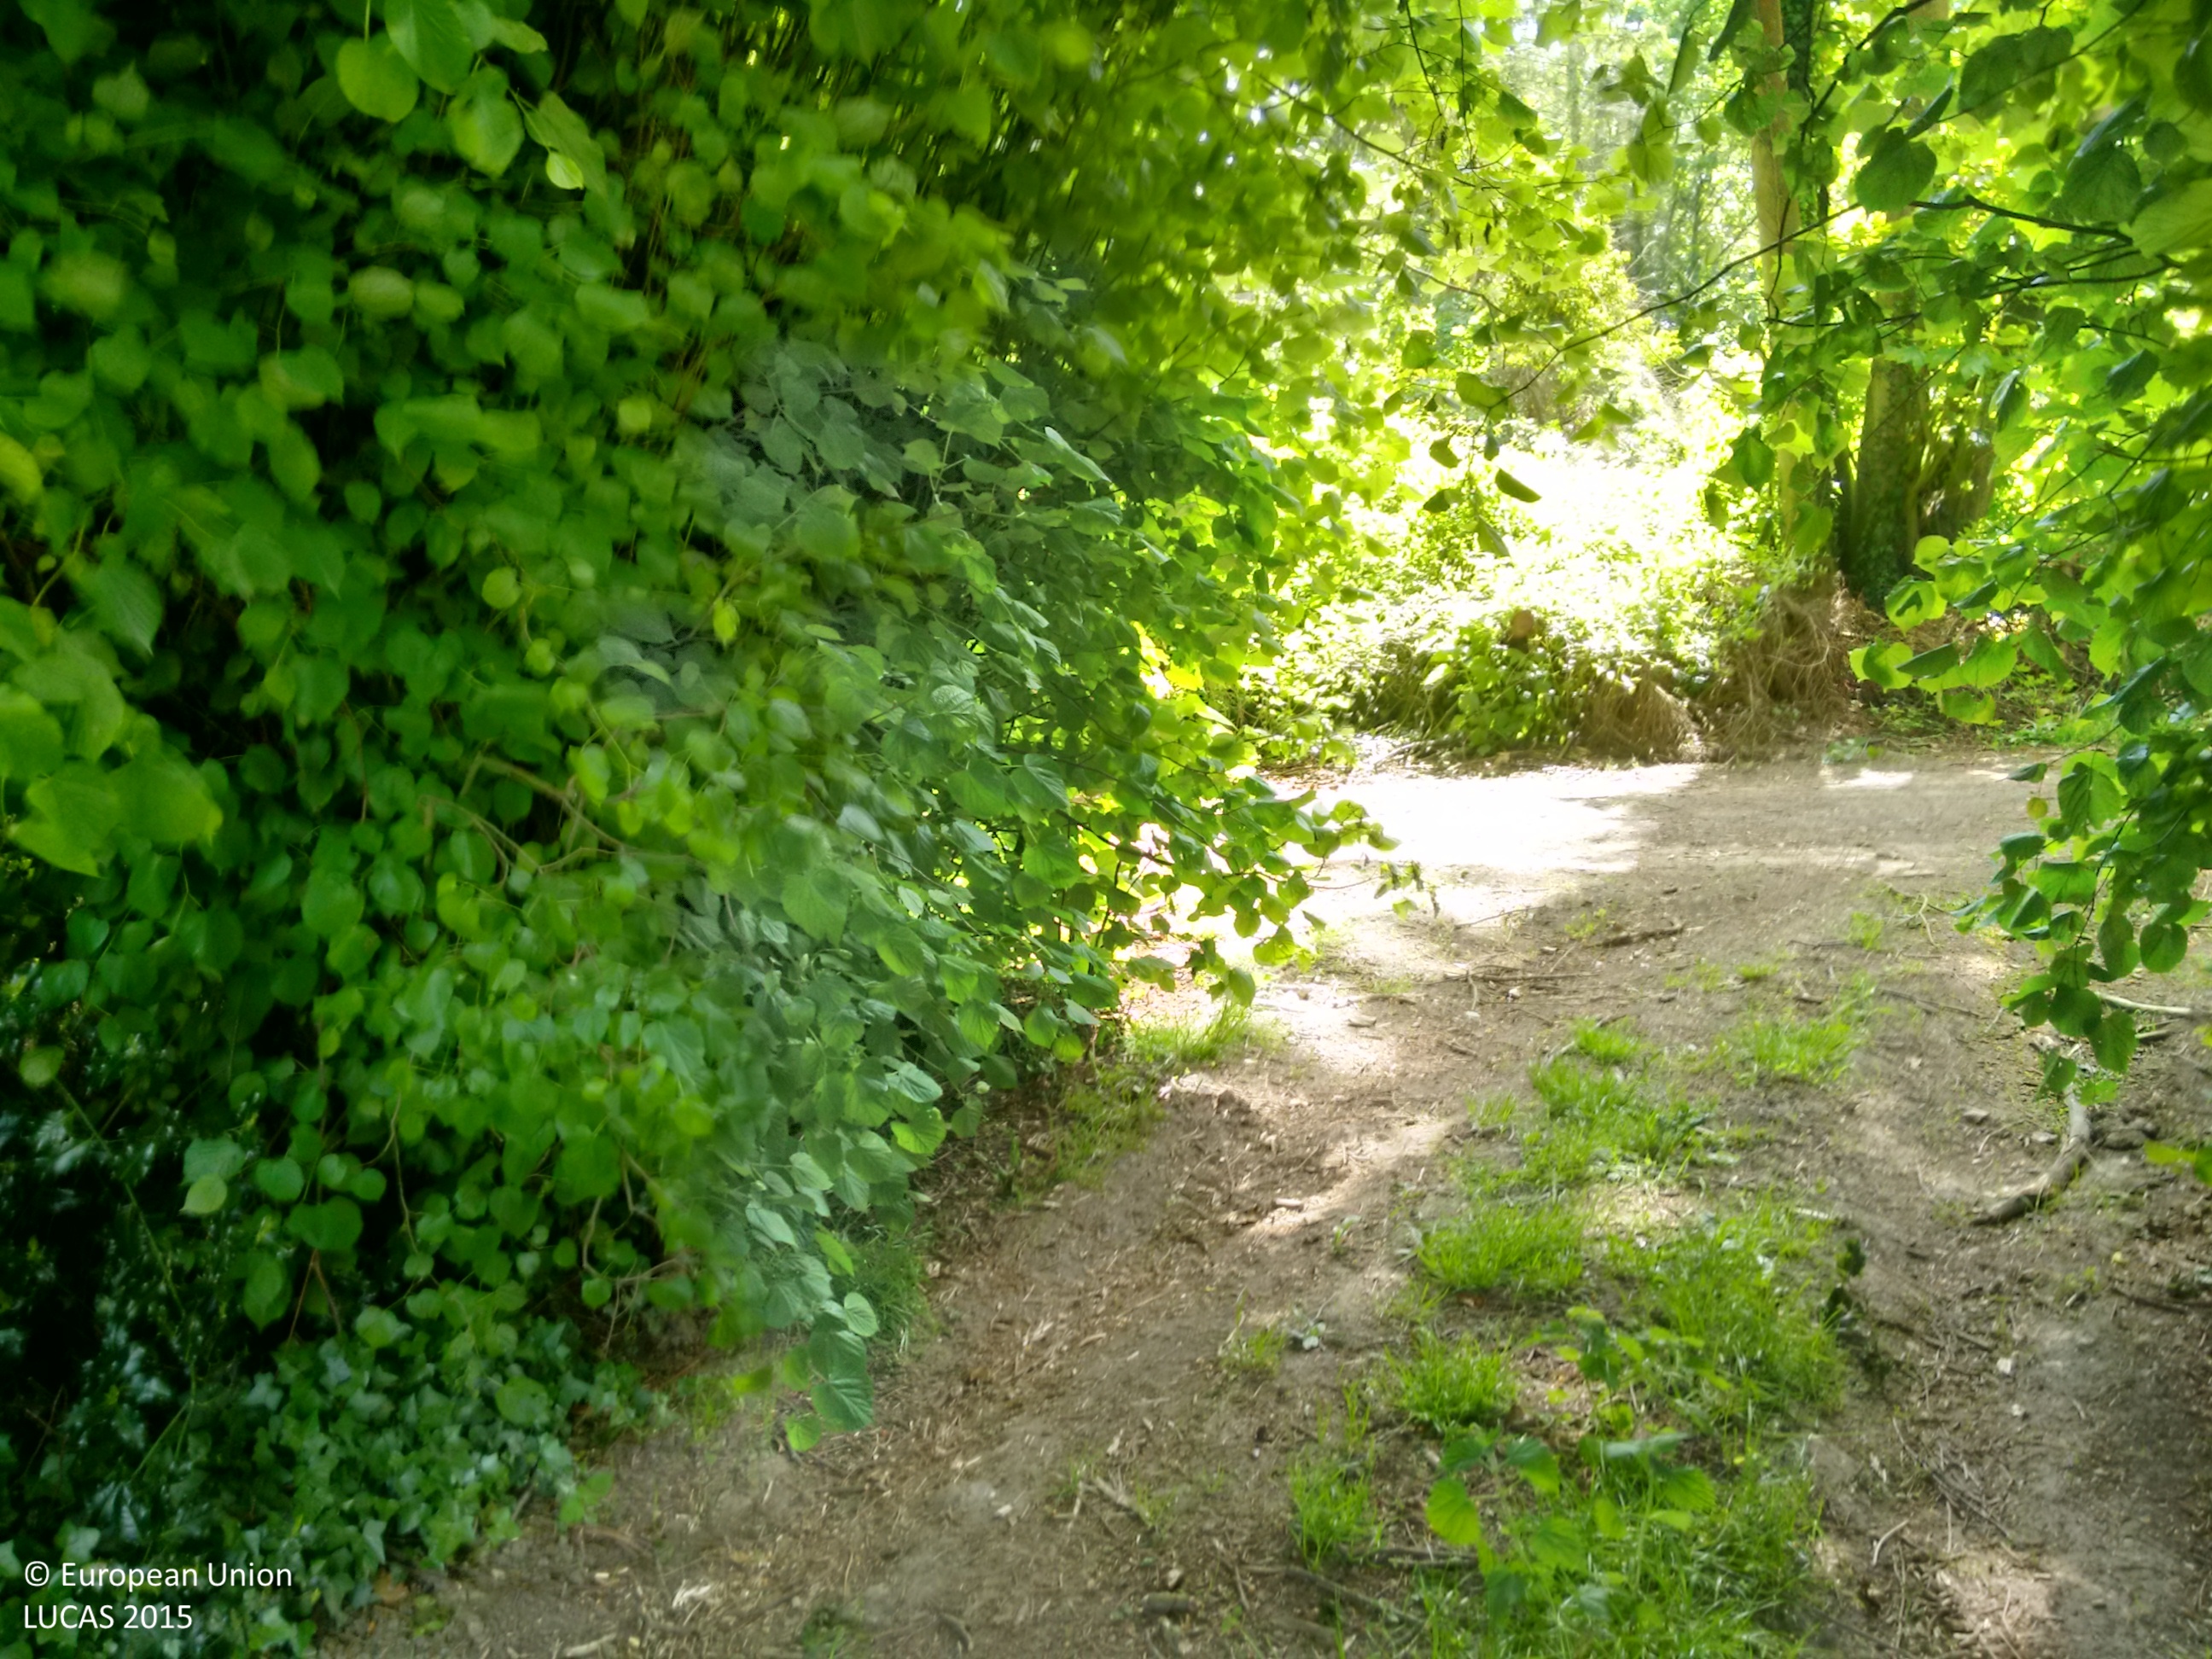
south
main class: Grassland
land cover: Grassland without tree/shrub cover
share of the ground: > 75 %
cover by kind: herbaceous plants 100 %
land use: Agriculture (excluding fallow land and kitchen gardens)
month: May
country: GB
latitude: 51.2340
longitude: 1.1699
